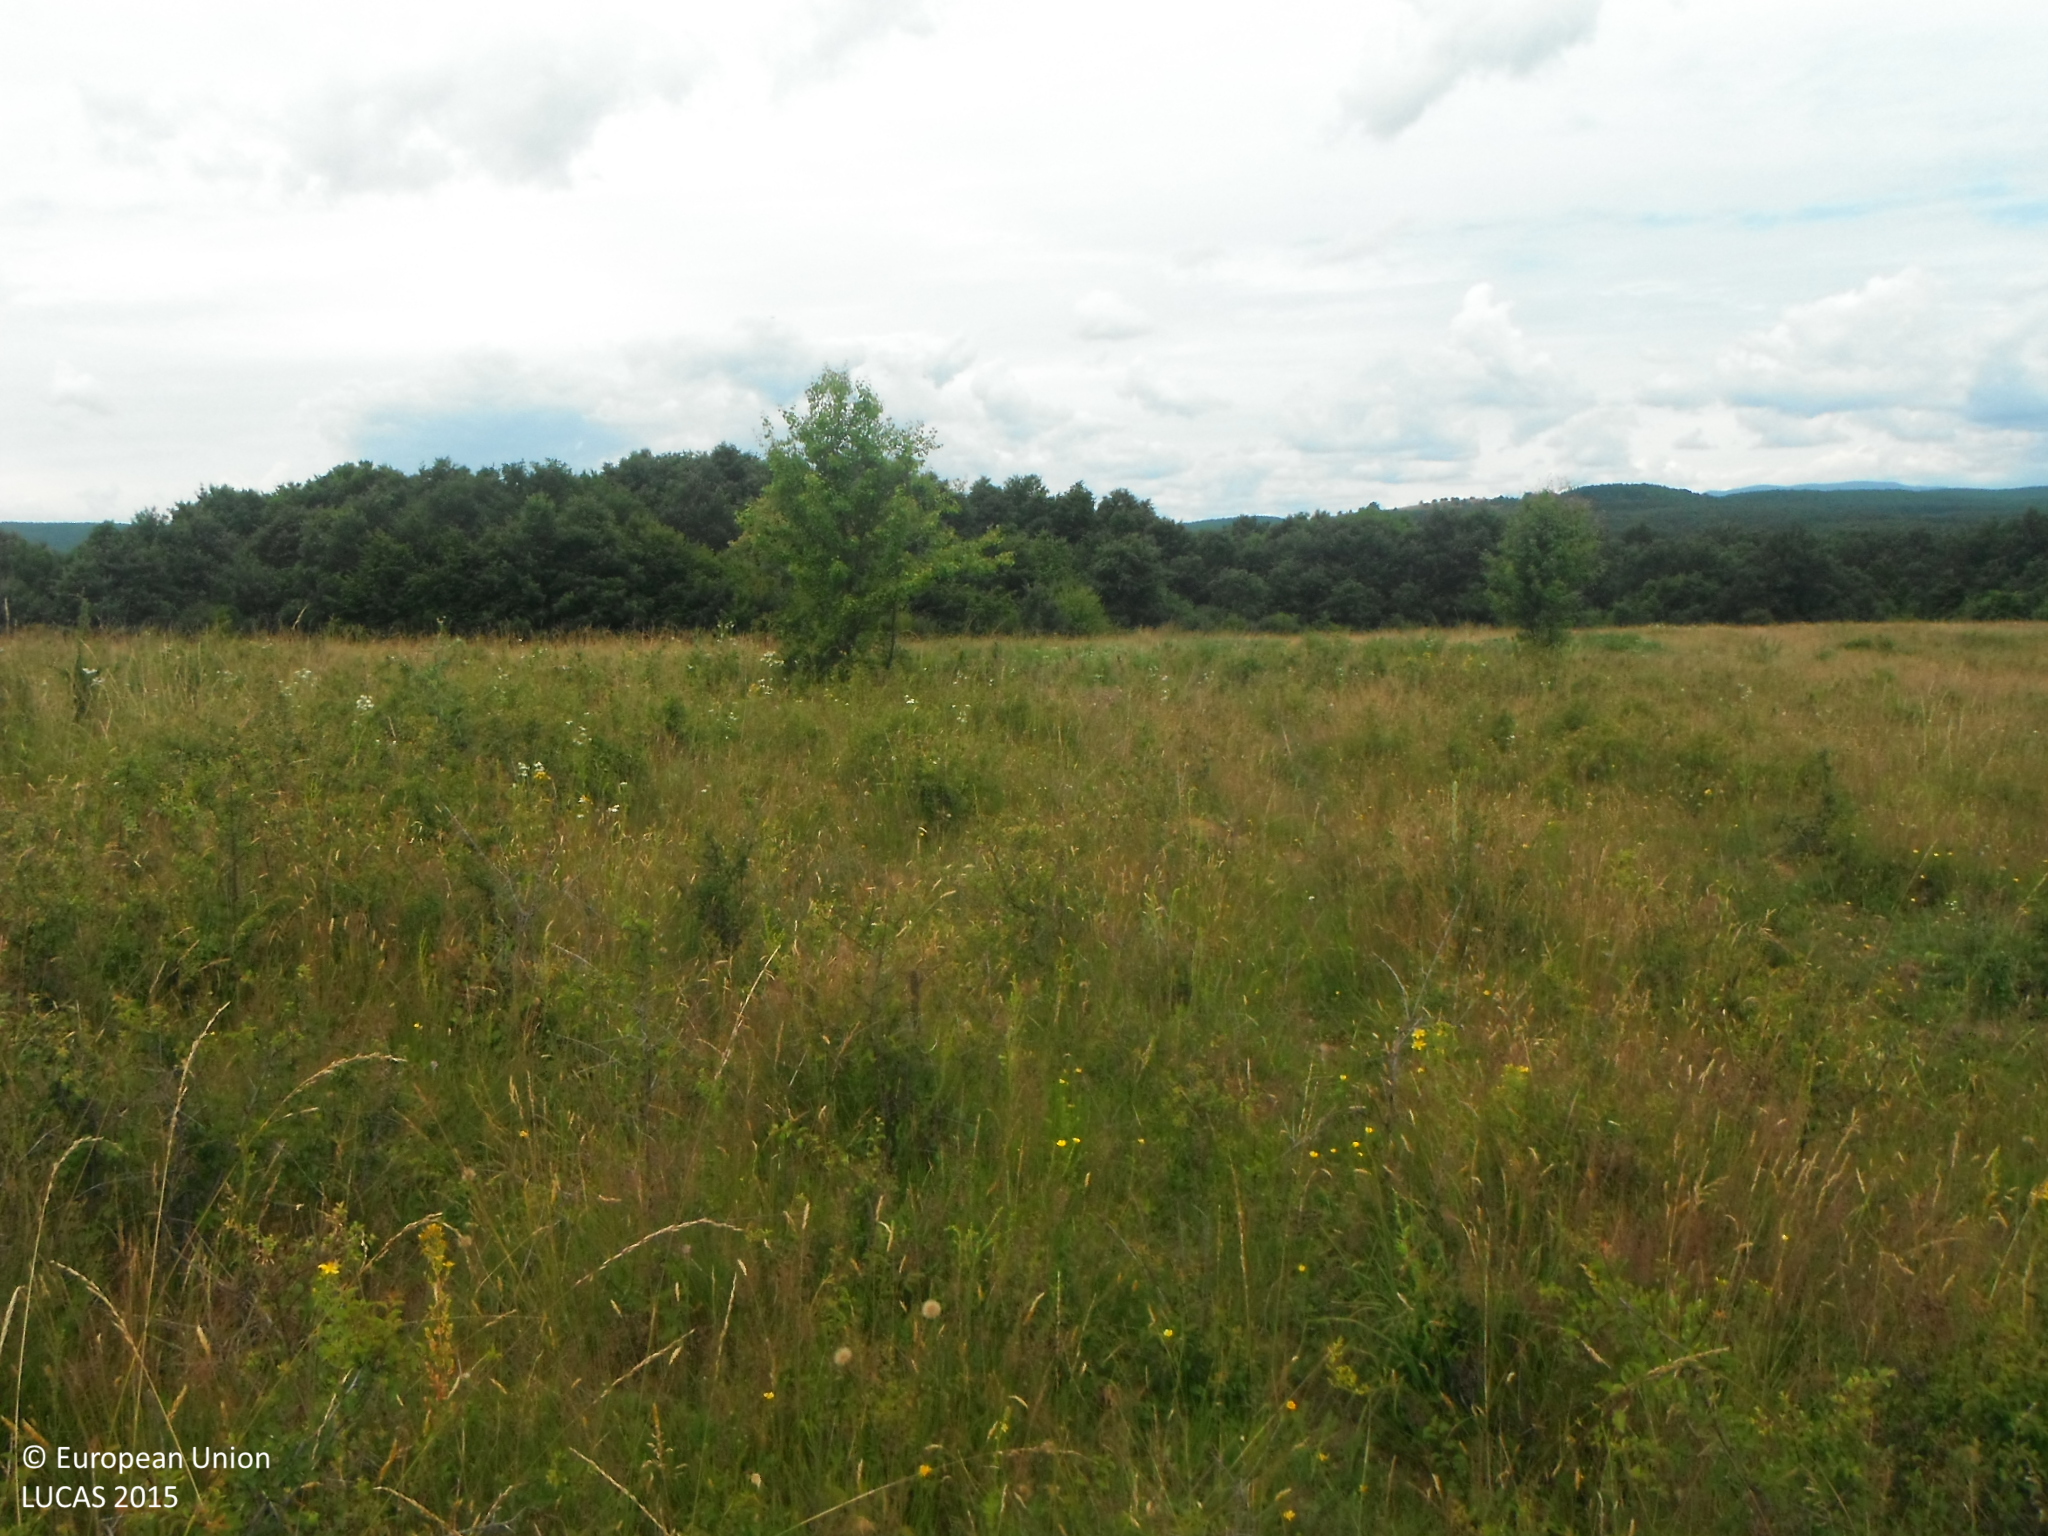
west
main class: Grassland
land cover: Grassland with sparse tree/shrub cover
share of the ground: > 75 %
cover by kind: herbaceous plants 90 %, broadleaved forest trees 5 %, shrubs 5 %
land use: Semi-natural and natural areas not in use
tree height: < 5 m
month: June
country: SK
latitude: 48.5086
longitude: 20.2245
